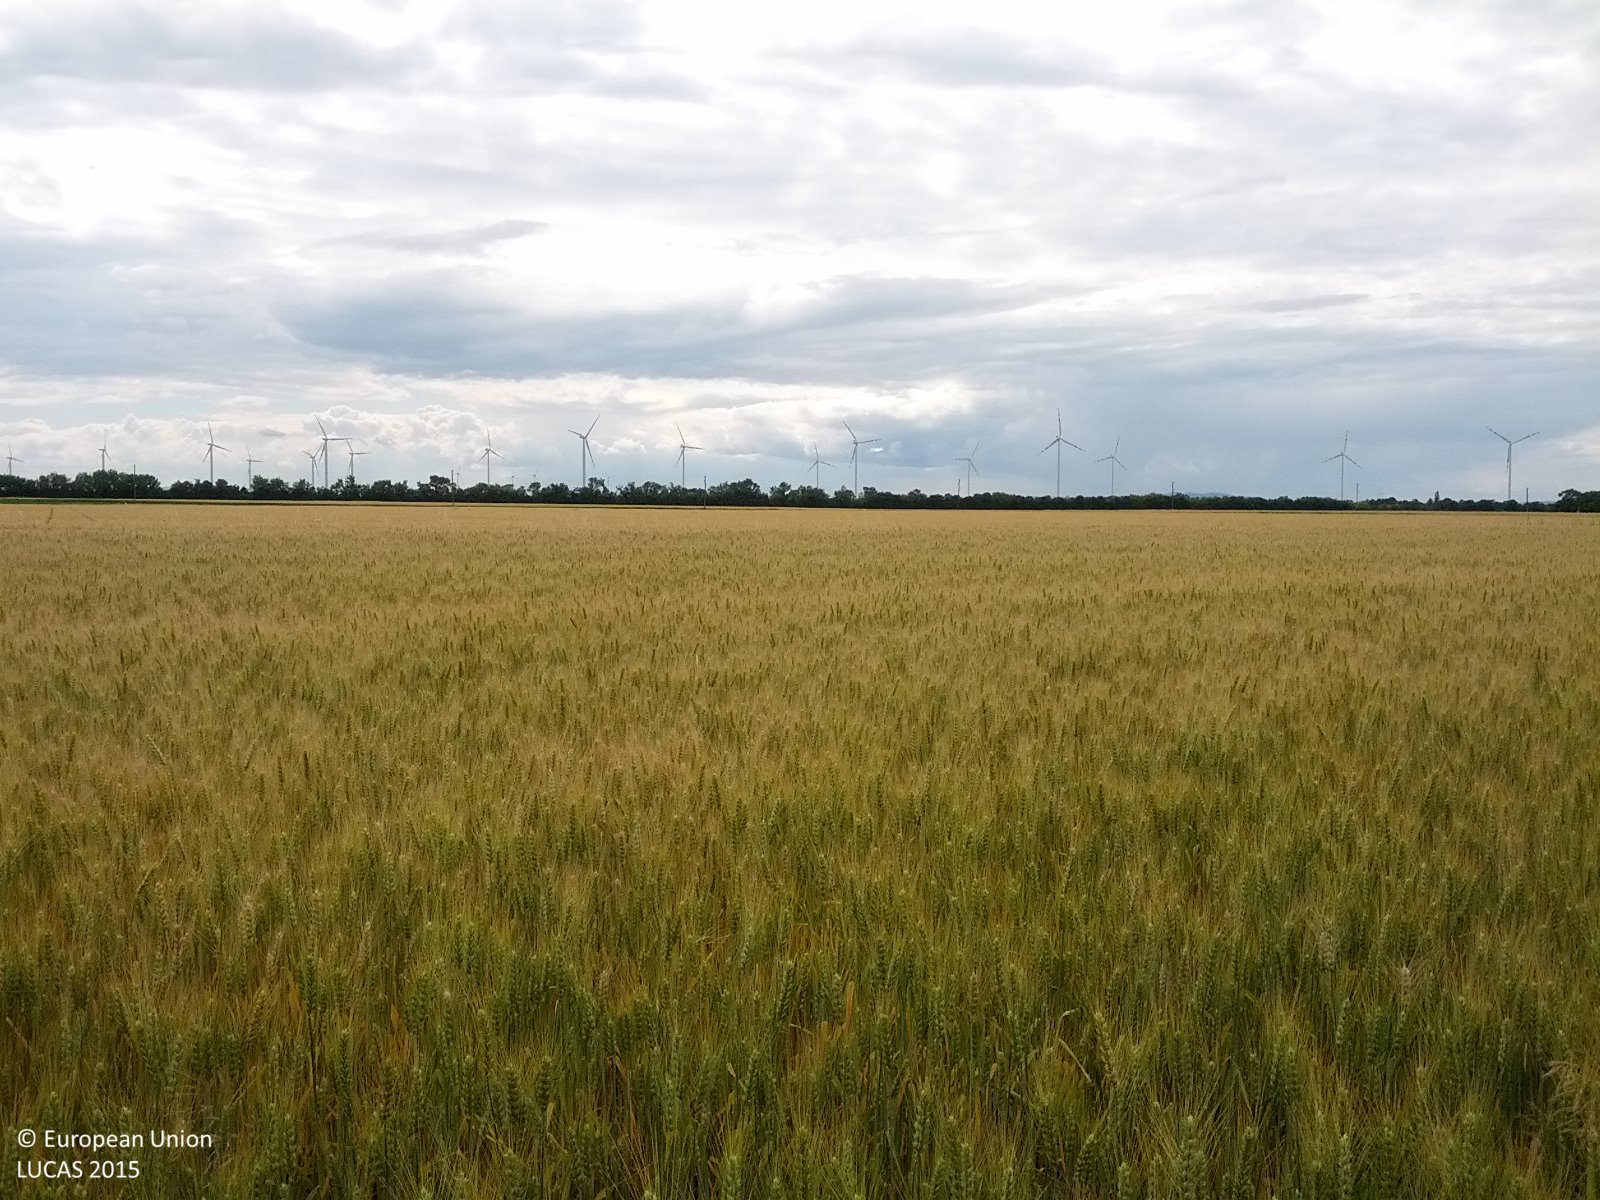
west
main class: Cropland
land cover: Durum wheat
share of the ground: > 75 %
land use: Agriculture (excluding fallow land and kitchen gardens)
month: June
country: AT
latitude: 48.2723
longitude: 16.7027
